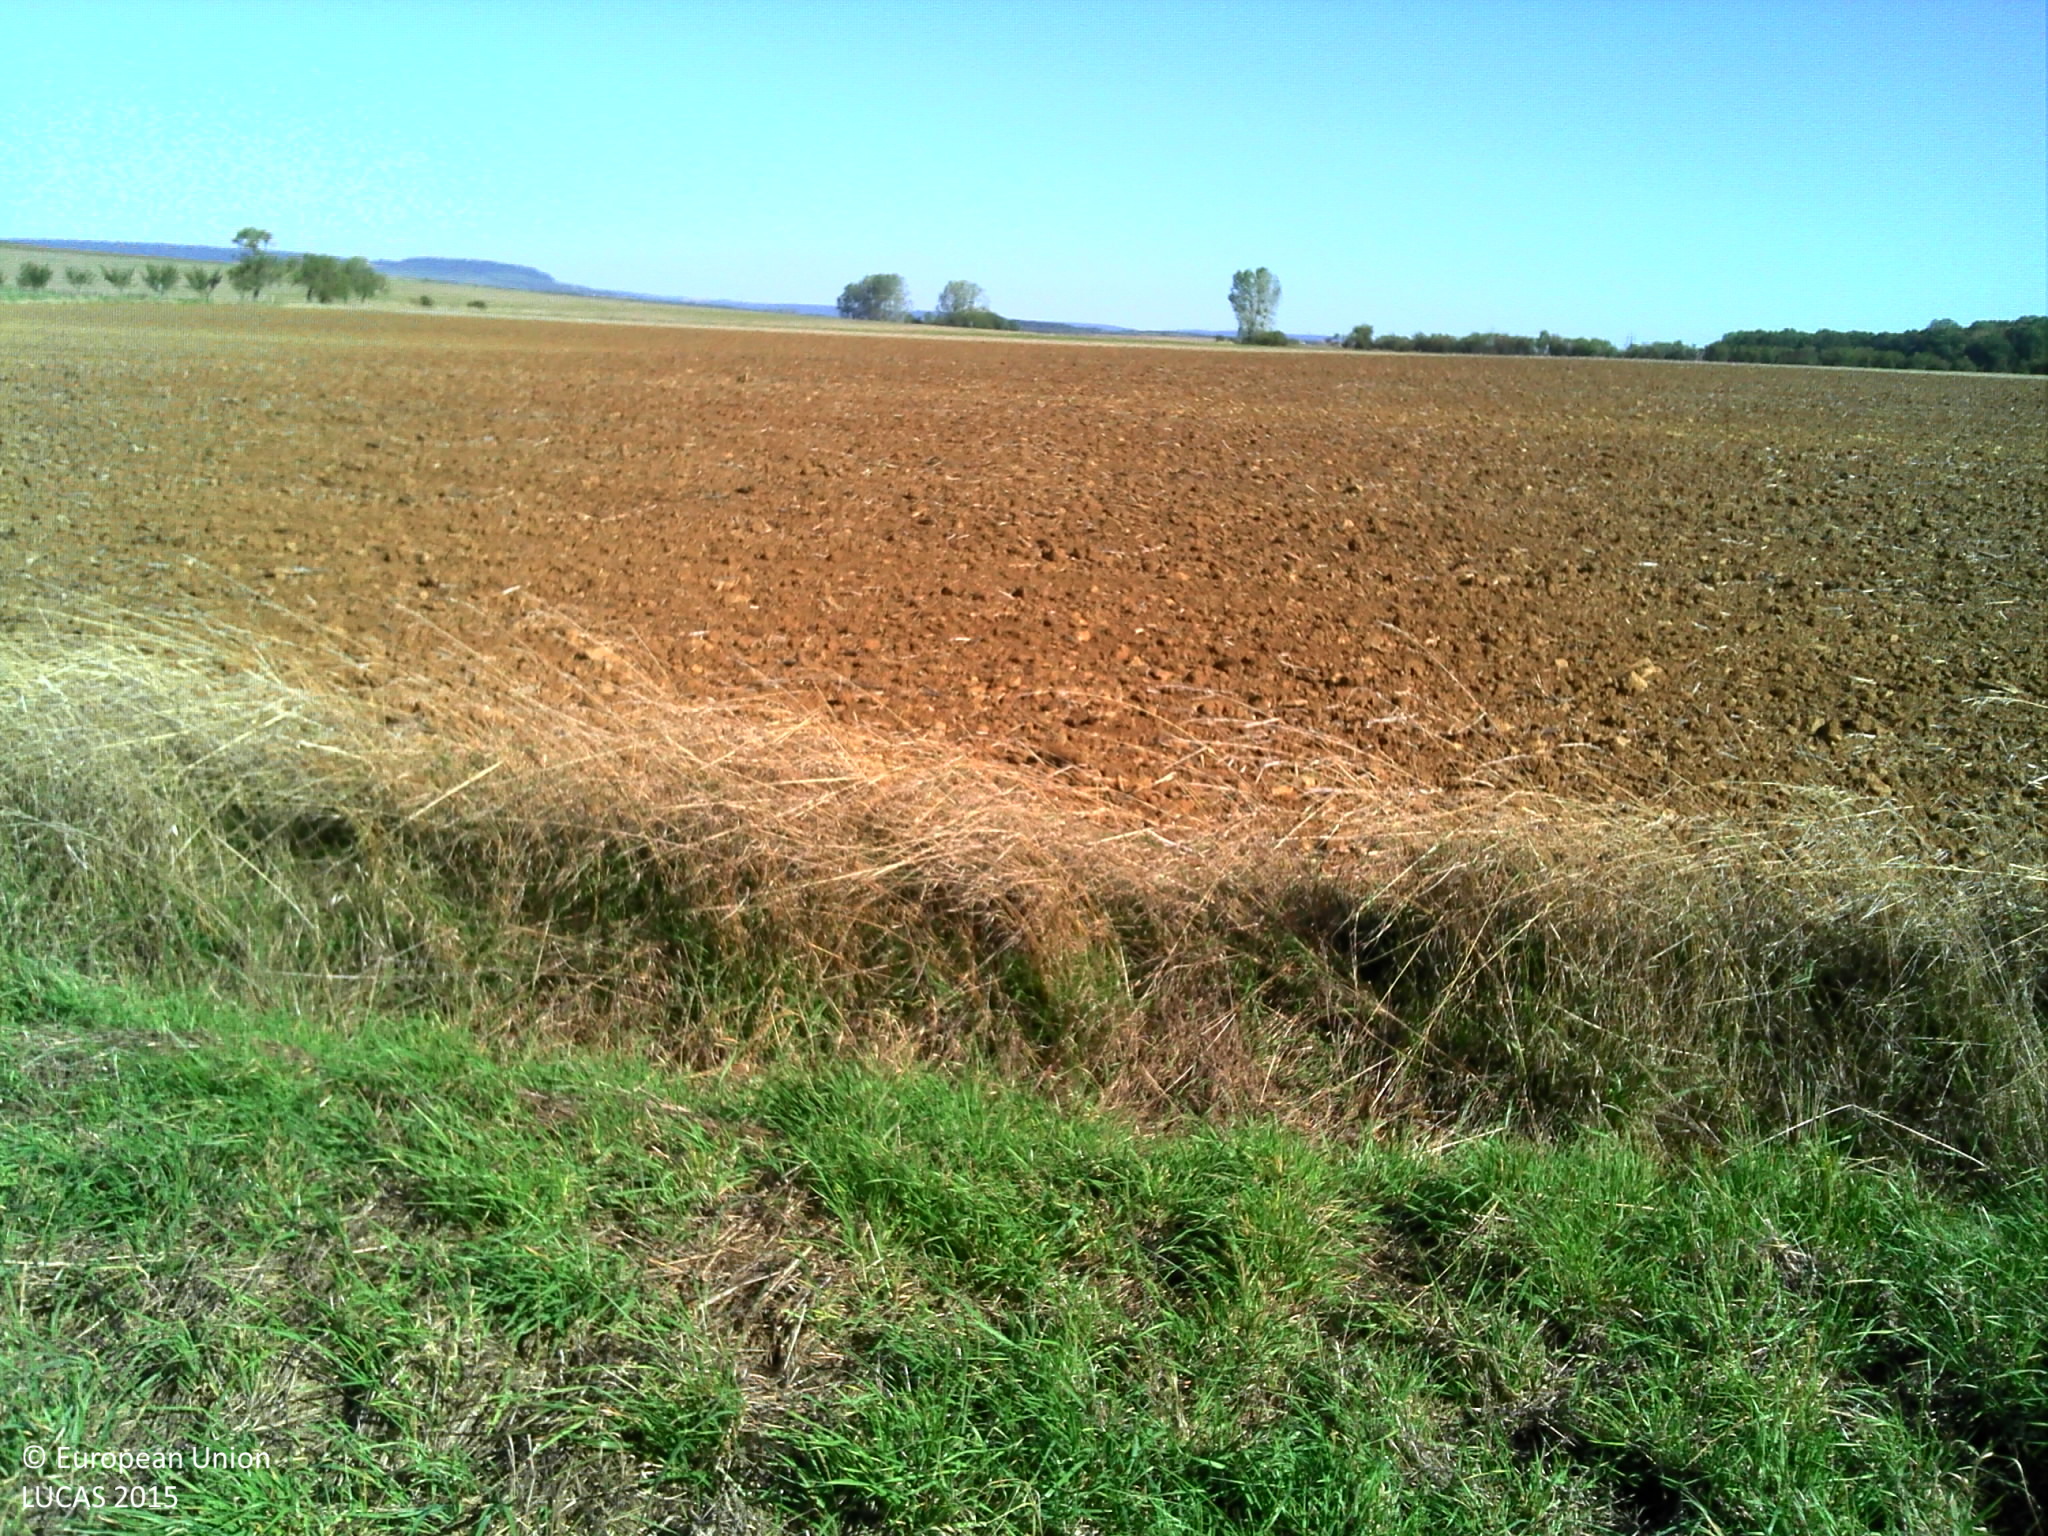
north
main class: Grassland
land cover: Grassland without tree/shrub cover
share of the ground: > 75 %
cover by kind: herbaceous plants 80 %, consolidated bare surface 20 %
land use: Road transport
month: September
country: FR
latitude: 48.4586
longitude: 6.0379
